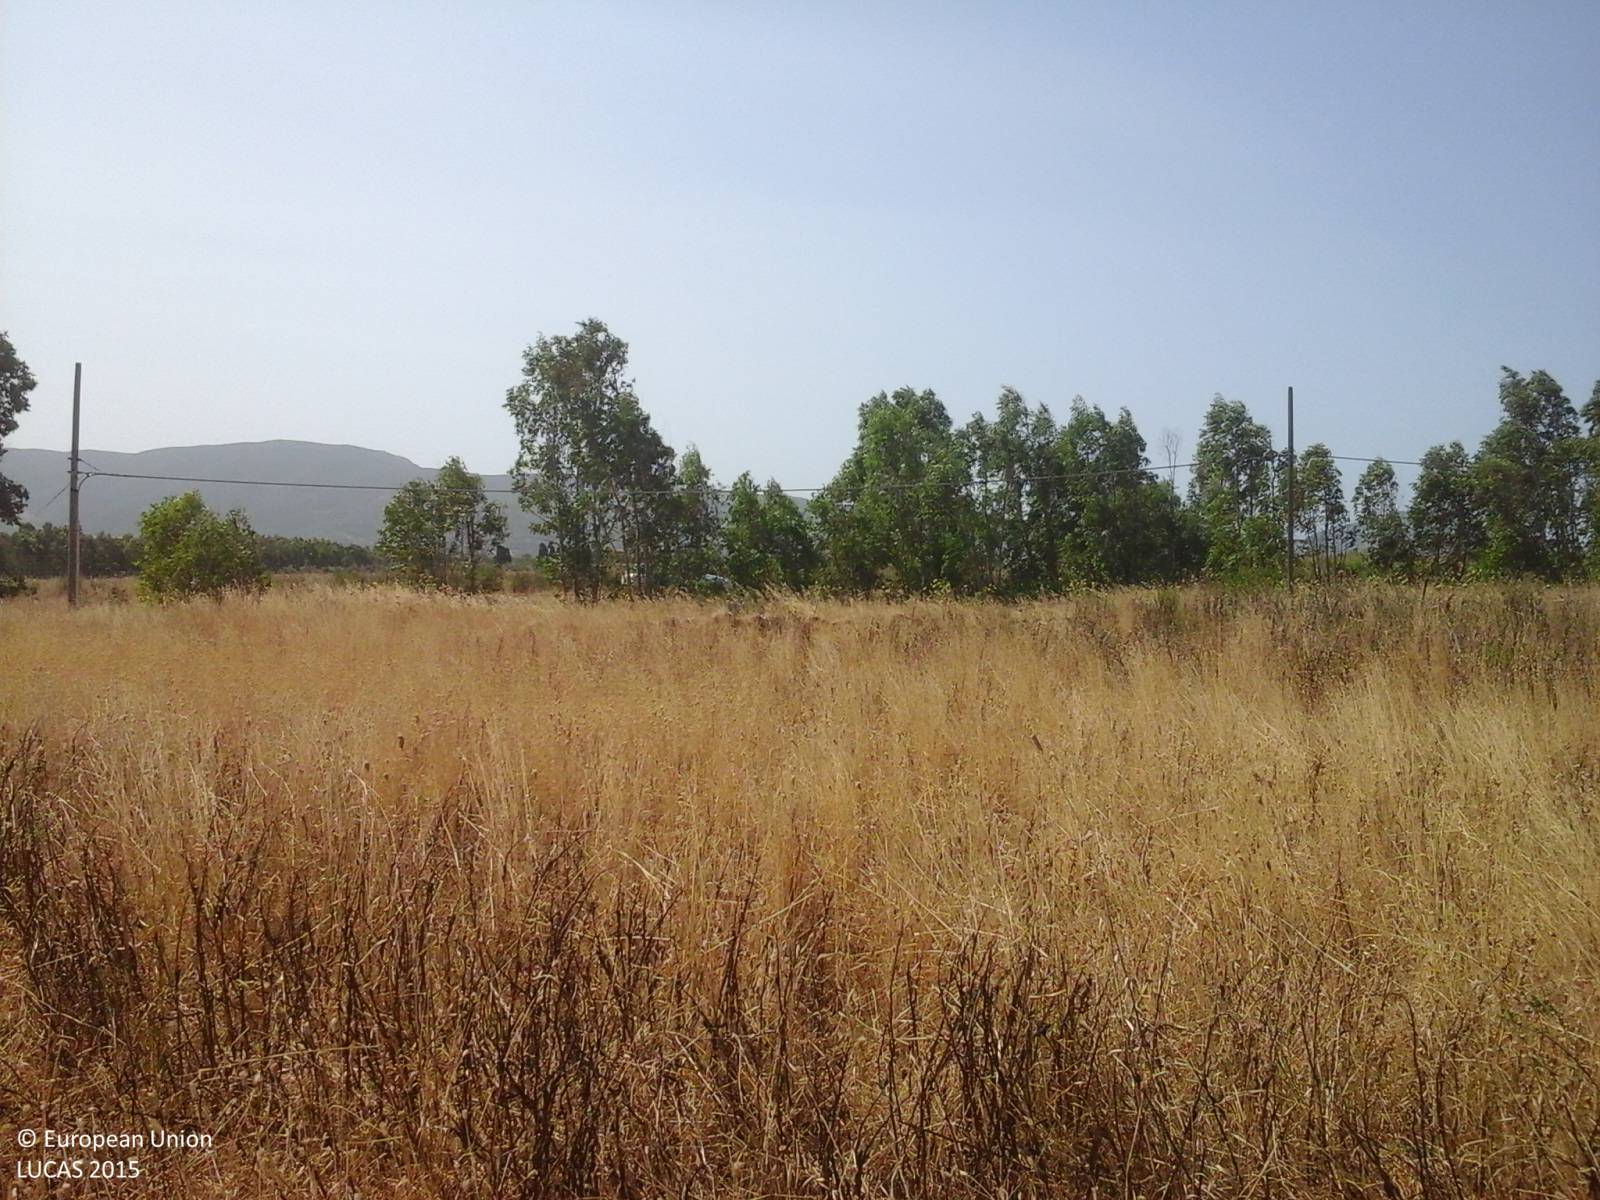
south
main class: Grassland
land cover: Grassland without tree/shrub cover
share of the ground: > 75 %
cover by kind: herbaceous plants 90 %, shrubs 5 %, unconsolidated bare surface 5 %
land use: Agriculture (excluding fallow land and kitchen gardens)
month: July
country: IT
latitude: 39.2786
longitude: 8.5598
